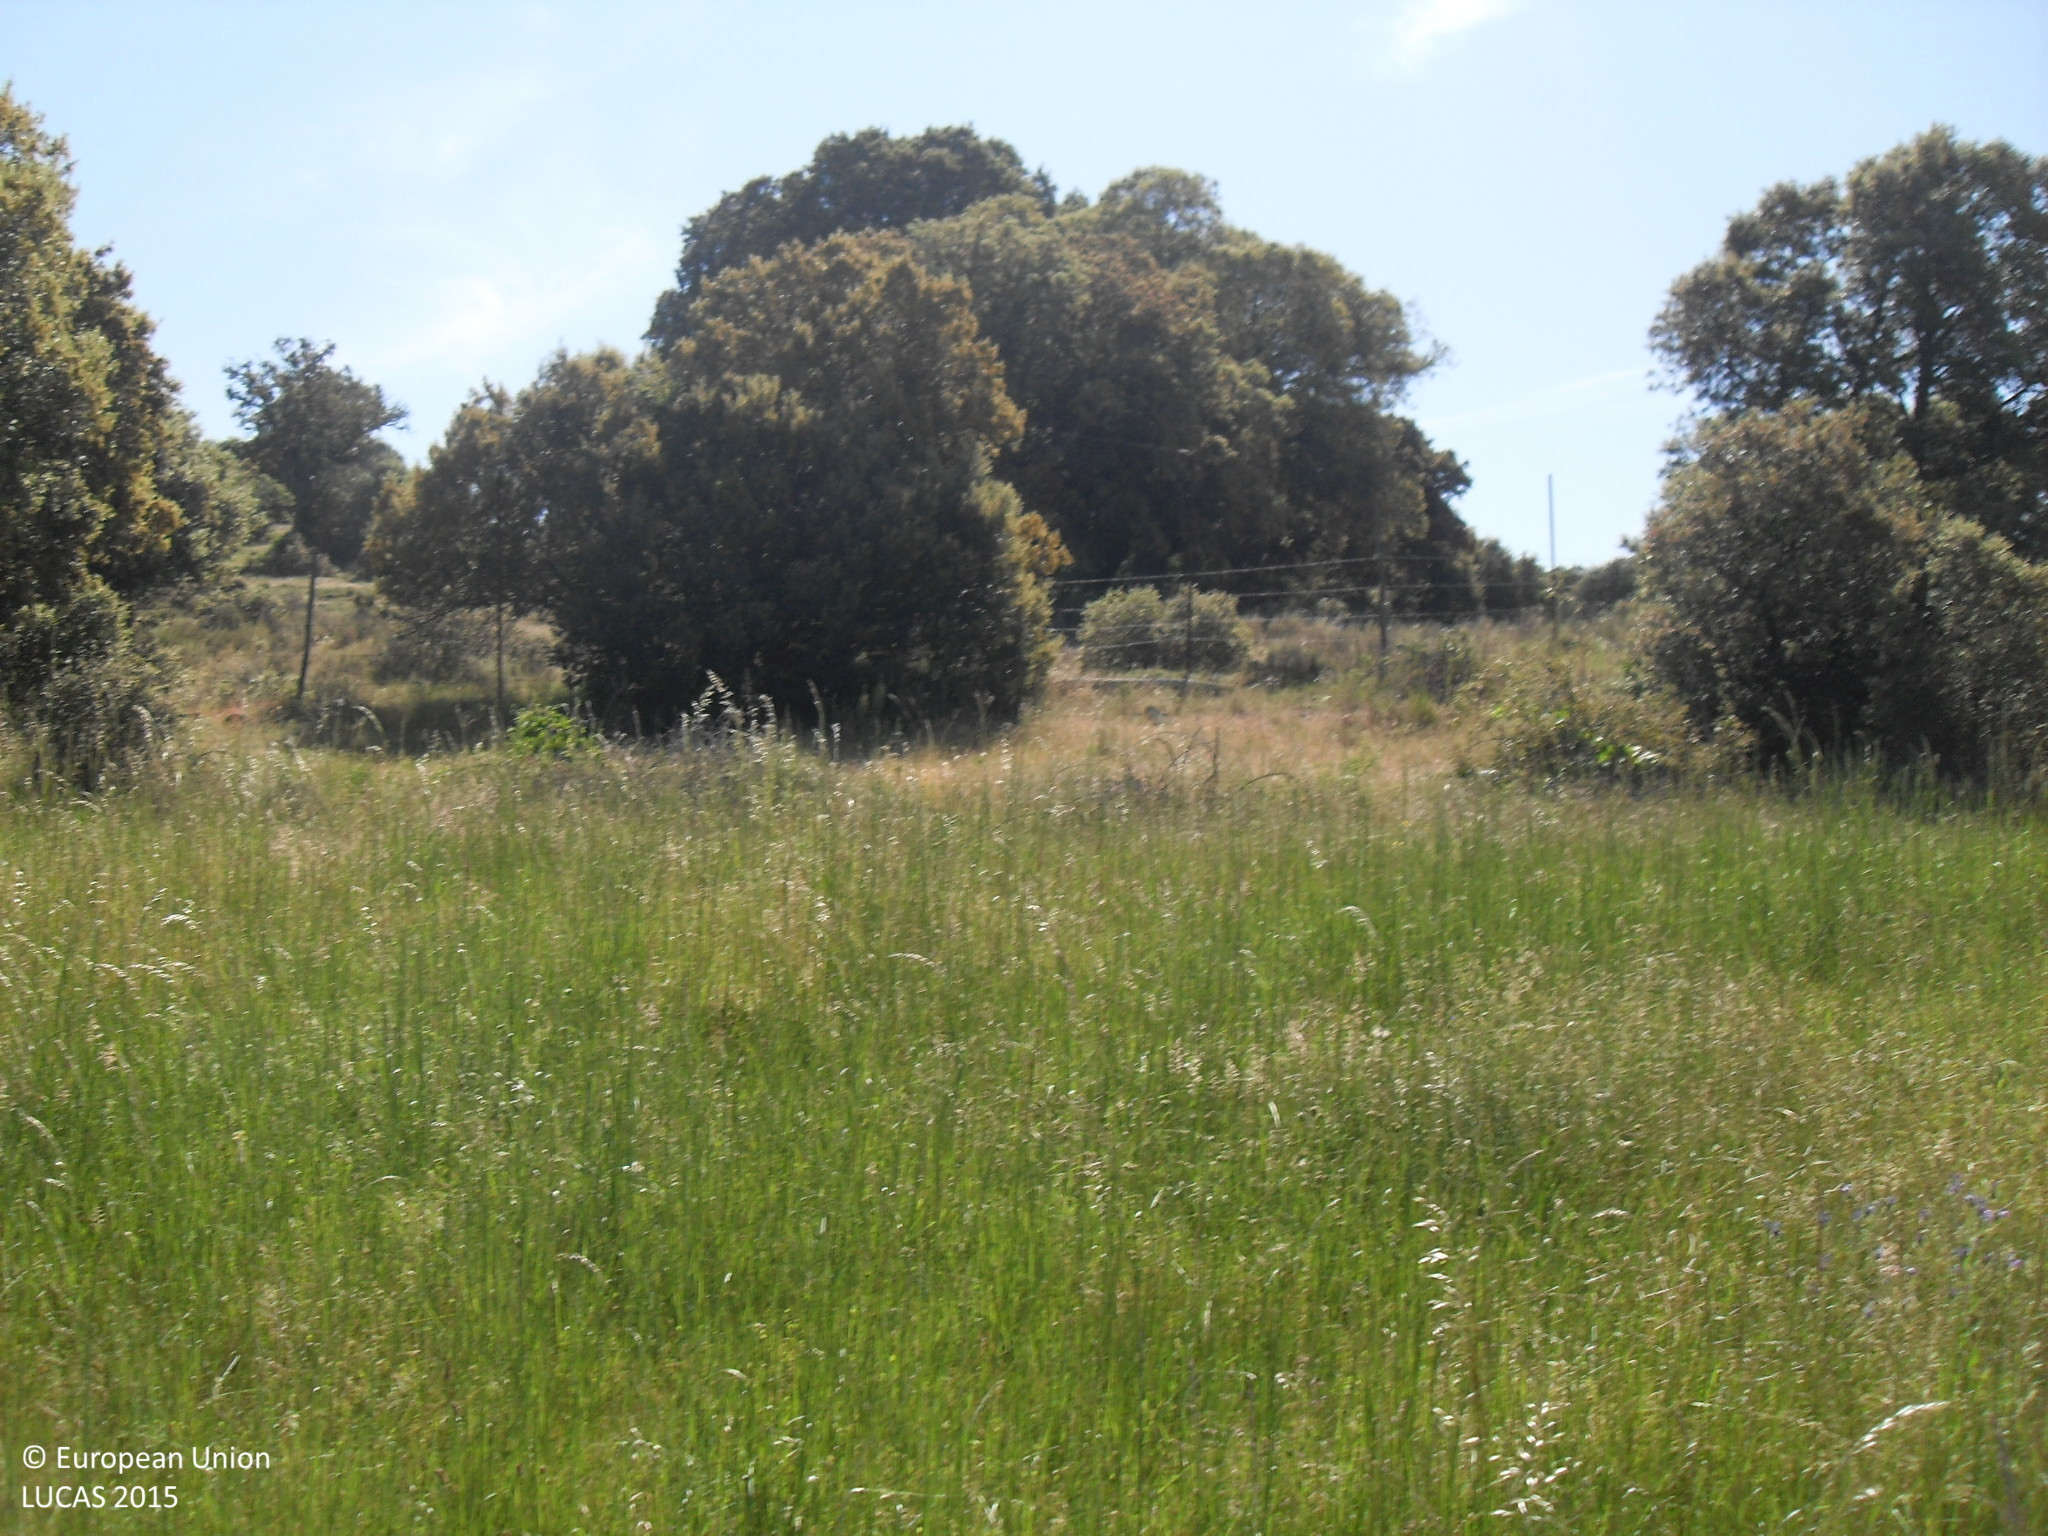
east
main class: Grassland
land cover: Grassland without tree/shrub cover
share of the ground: > 75 %
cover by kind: herbaceous plants 100 %
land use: Agriculture (excluding fallow land and kitchen gardens)
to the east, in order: Grassland without tree/shrub cover; Fences; Grassland with sparse tree/shrub cover; Tracks; Grassland with sparse tree/shrub cover
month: May
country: ES
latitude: 40.4967
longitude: -5.2723
